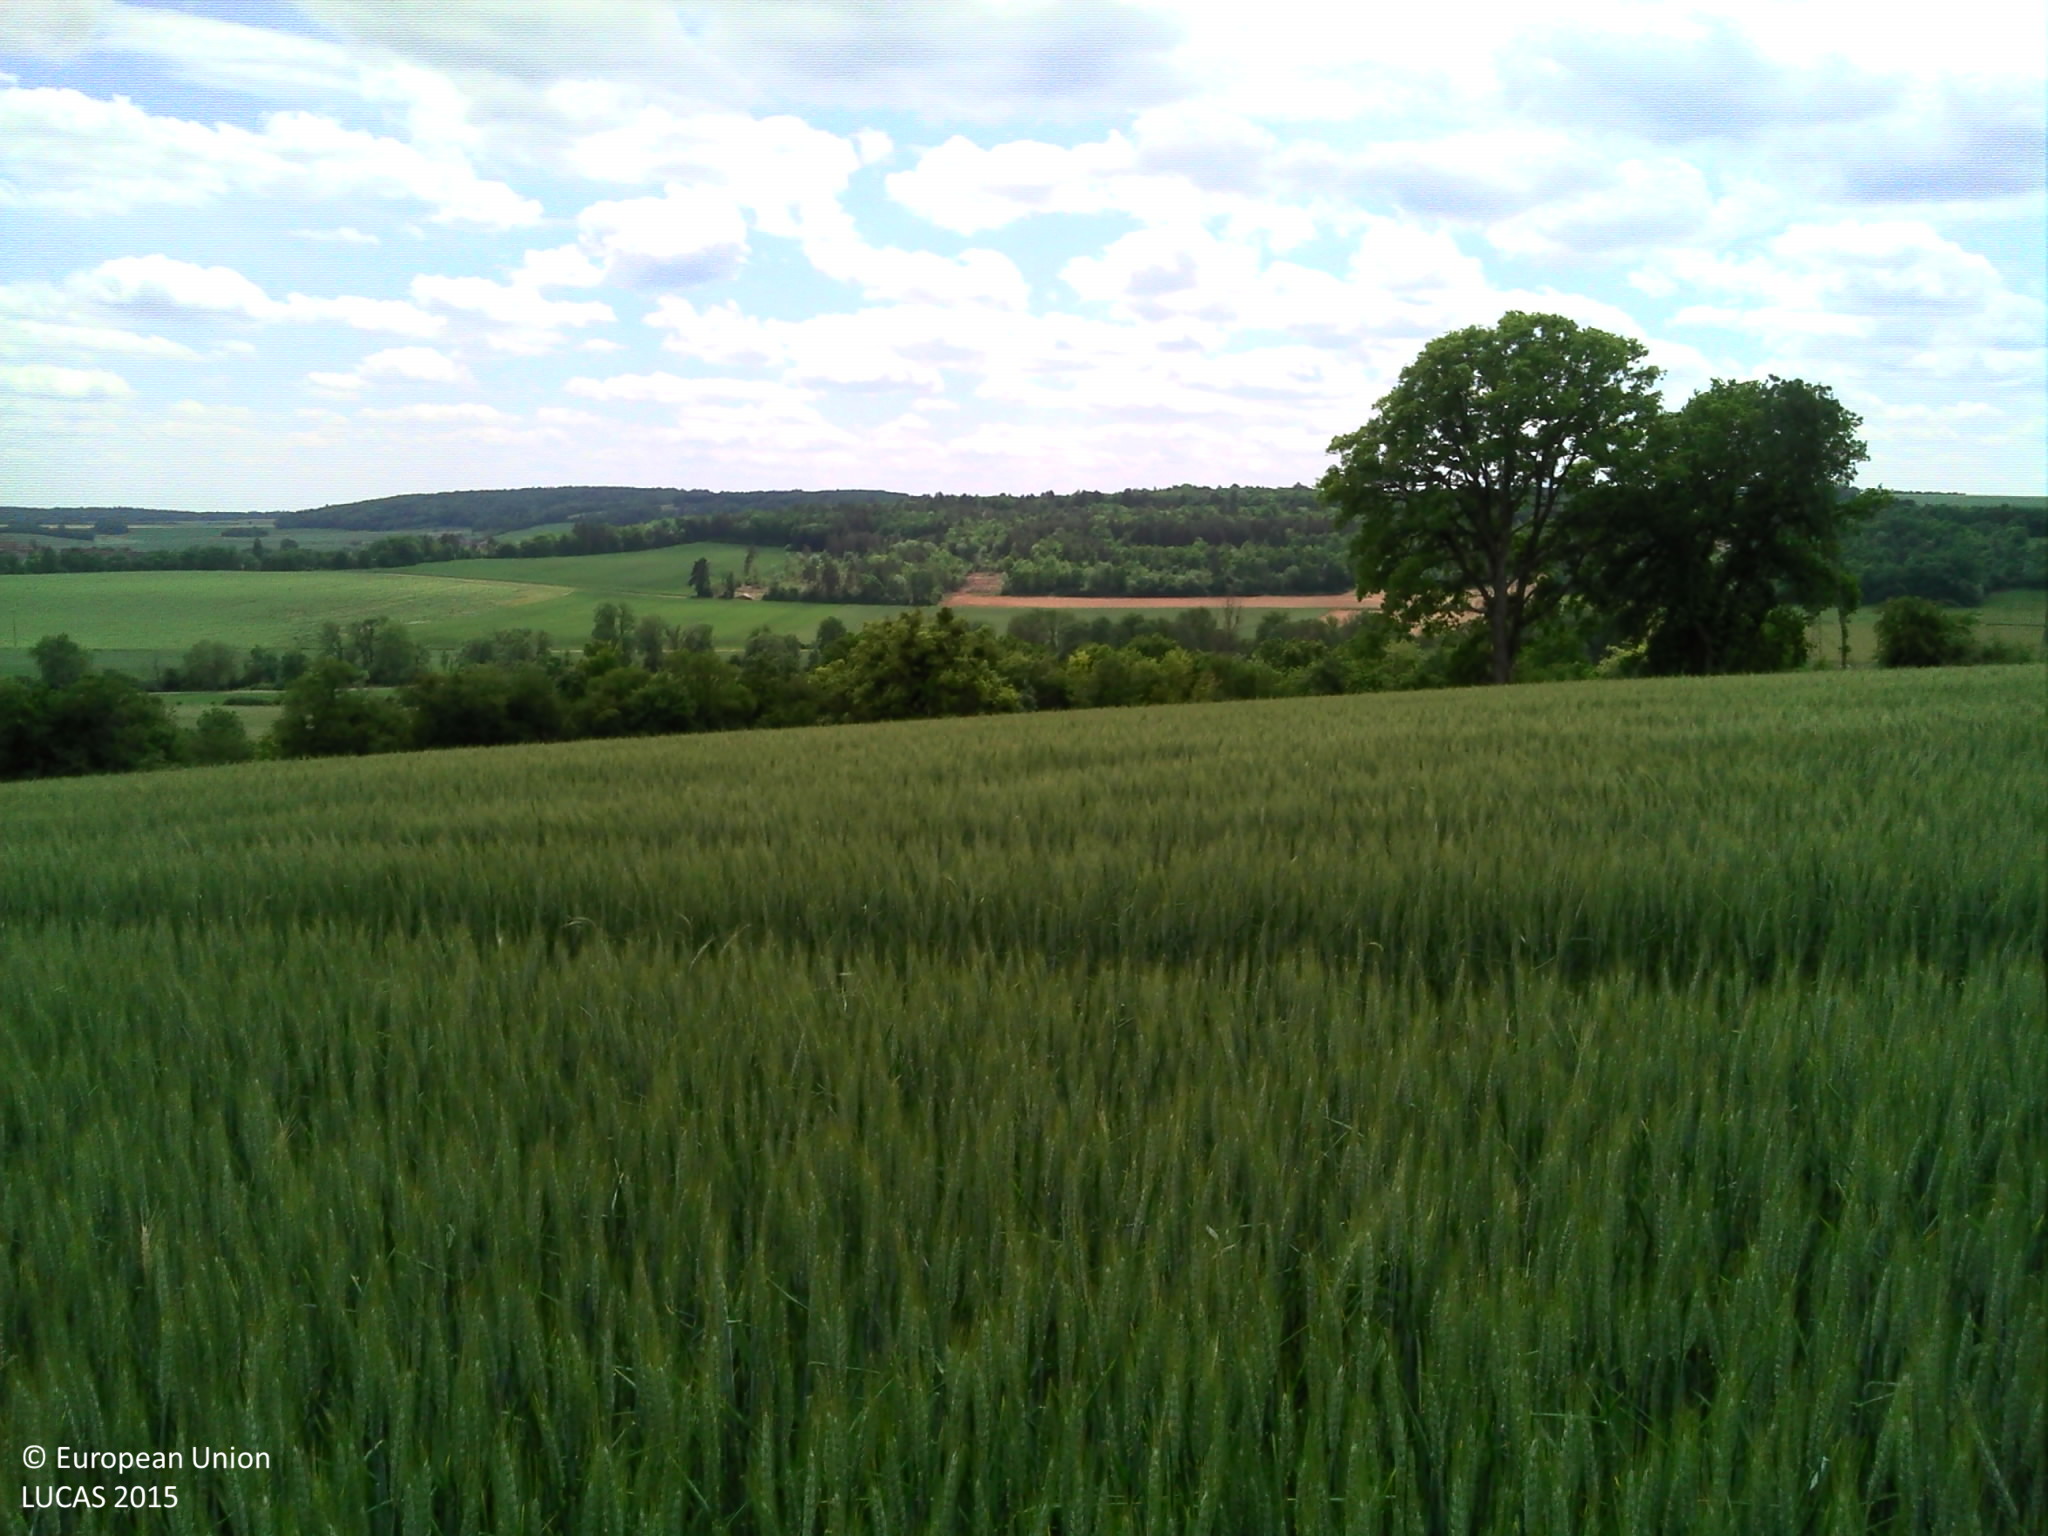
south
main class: Cropland
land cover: Common wheat
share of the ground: > 75 %
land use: Agriculture (excluding fallow land and kitchen gardens)
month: May
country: FR
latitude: 47.7494
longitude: 3.9281
